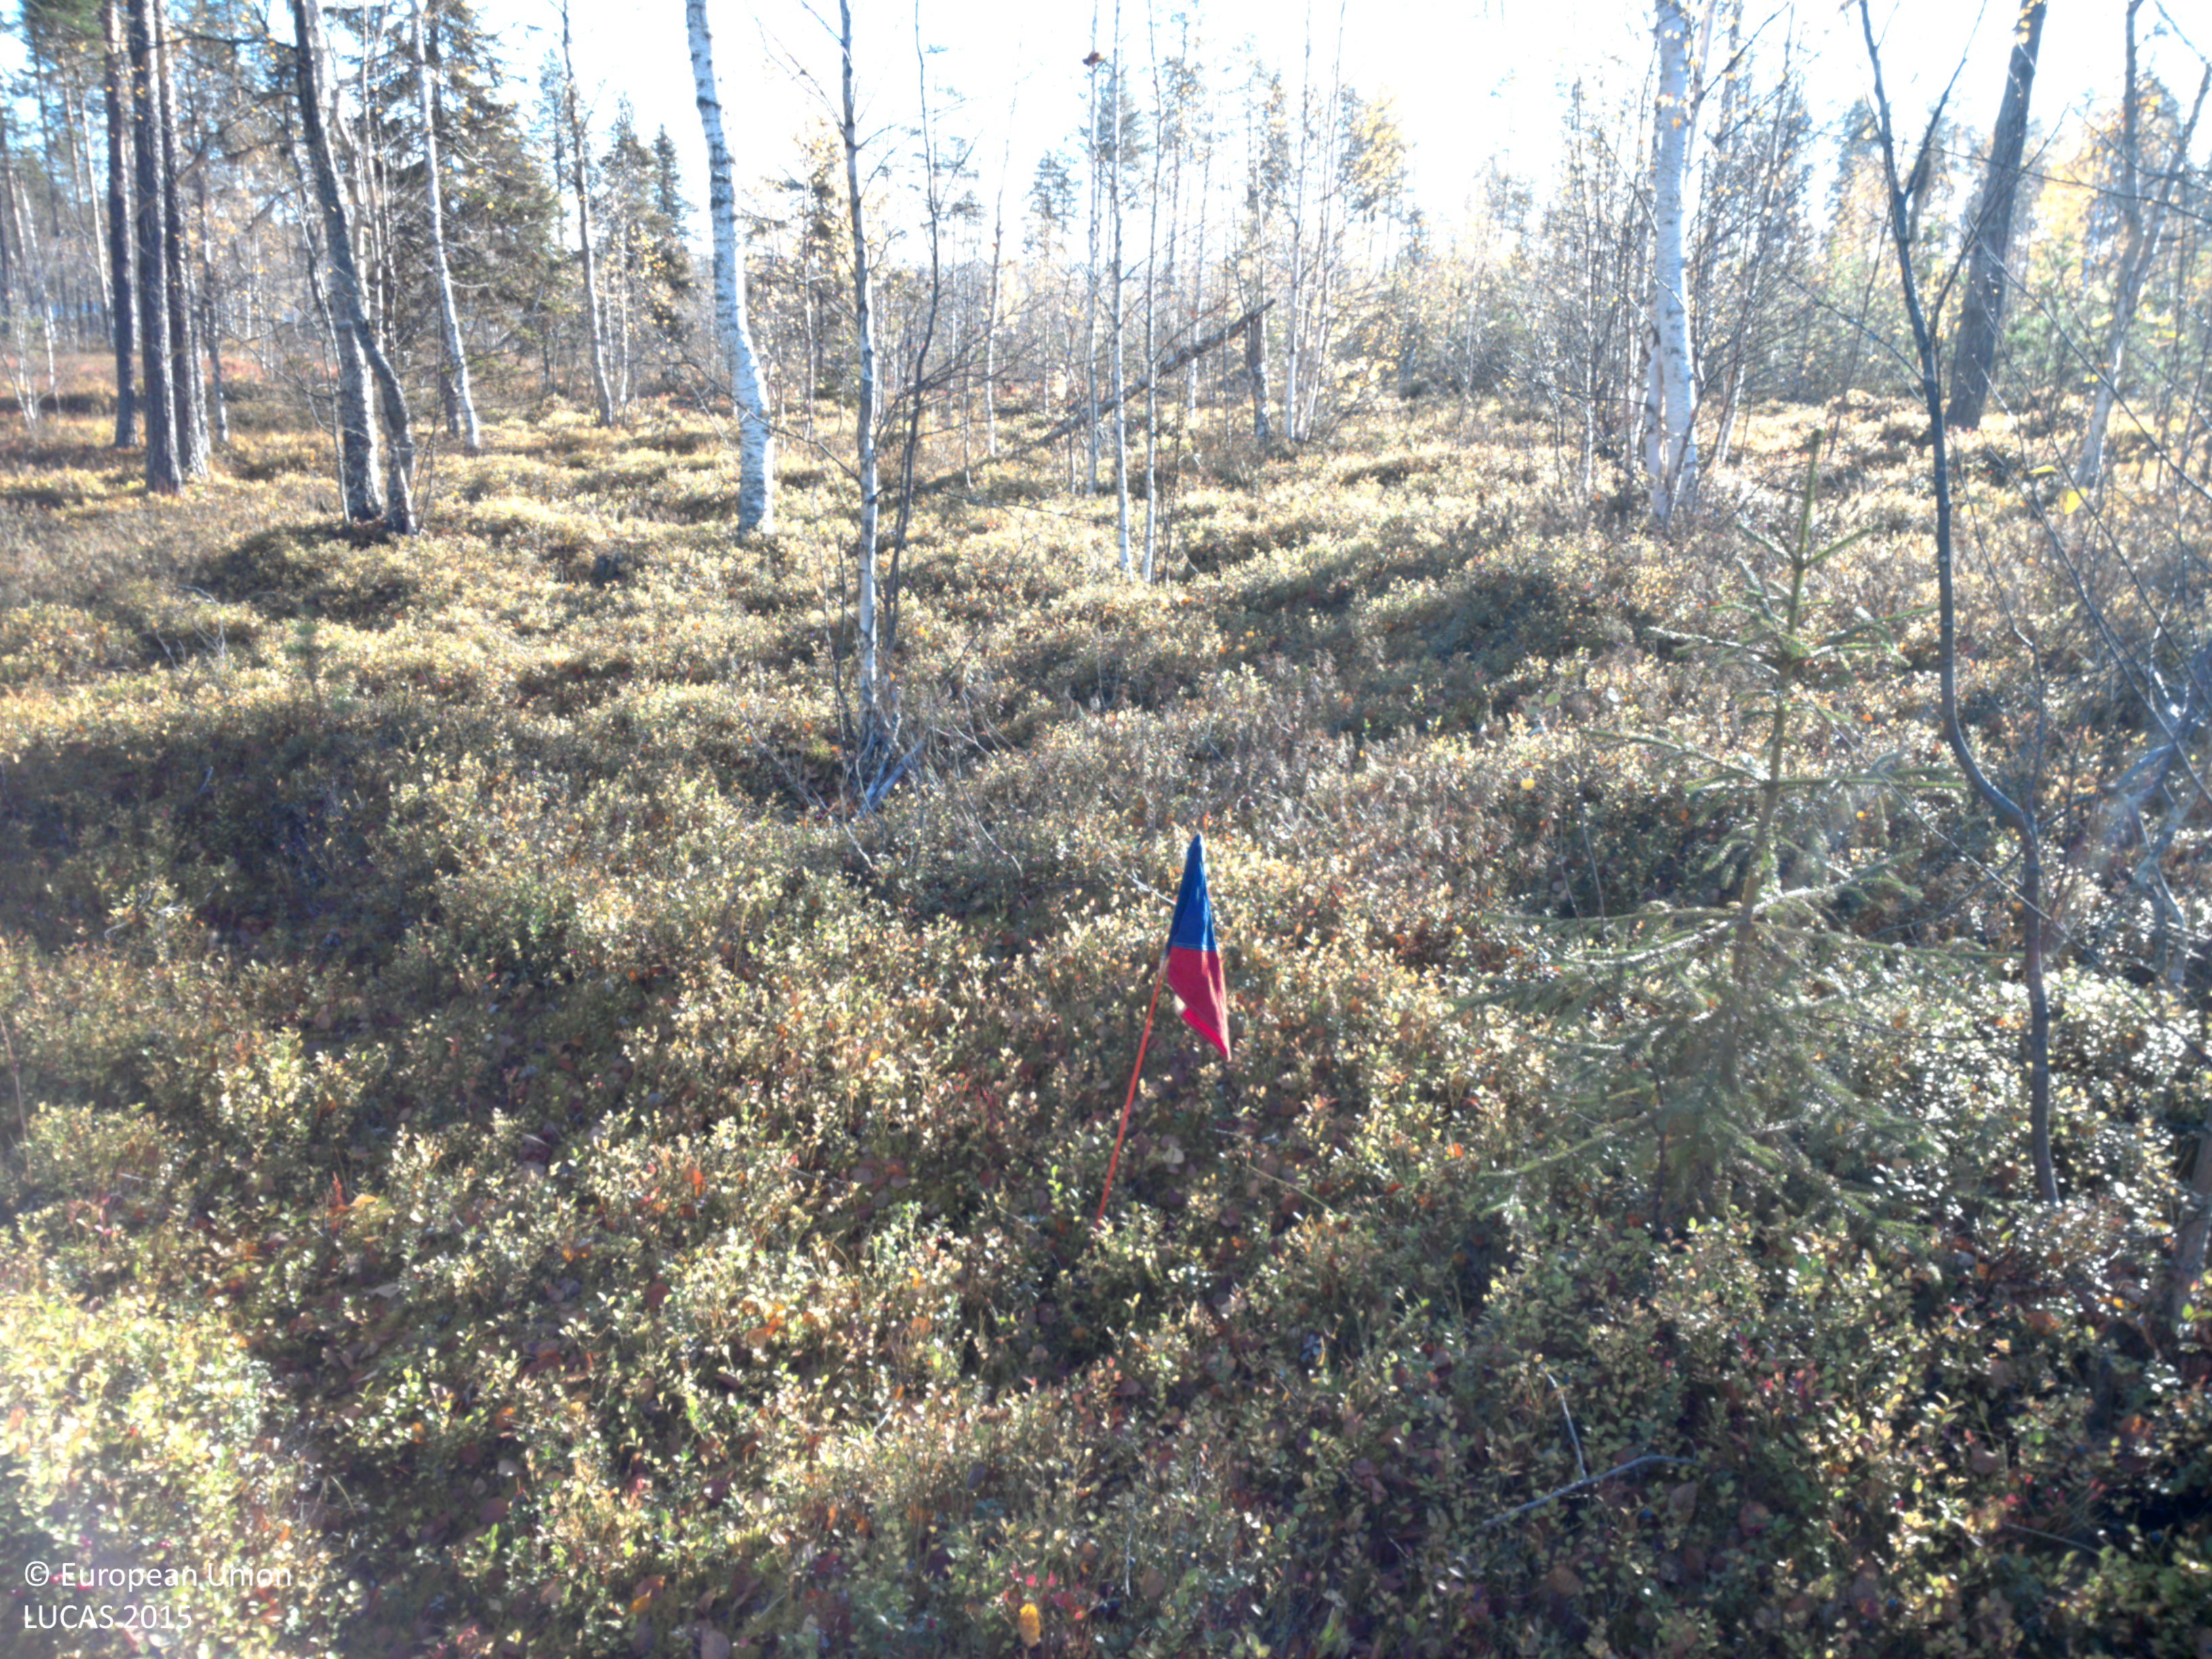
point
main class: Woodland
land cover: Broadleaved woodland
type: hemiboreal forest and nemoral coniferous forest and mixed broadleaved-coniferous forest
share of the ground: 50 - 75 %
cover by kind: broadleaved forest trees 50 %, shrubs 40 %, coniferous forest trees 5 %, lichens and mosses 5 %
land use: Forestry
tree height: > 5 m
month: September
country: SE
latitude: 64.8405
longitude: 18.5457
